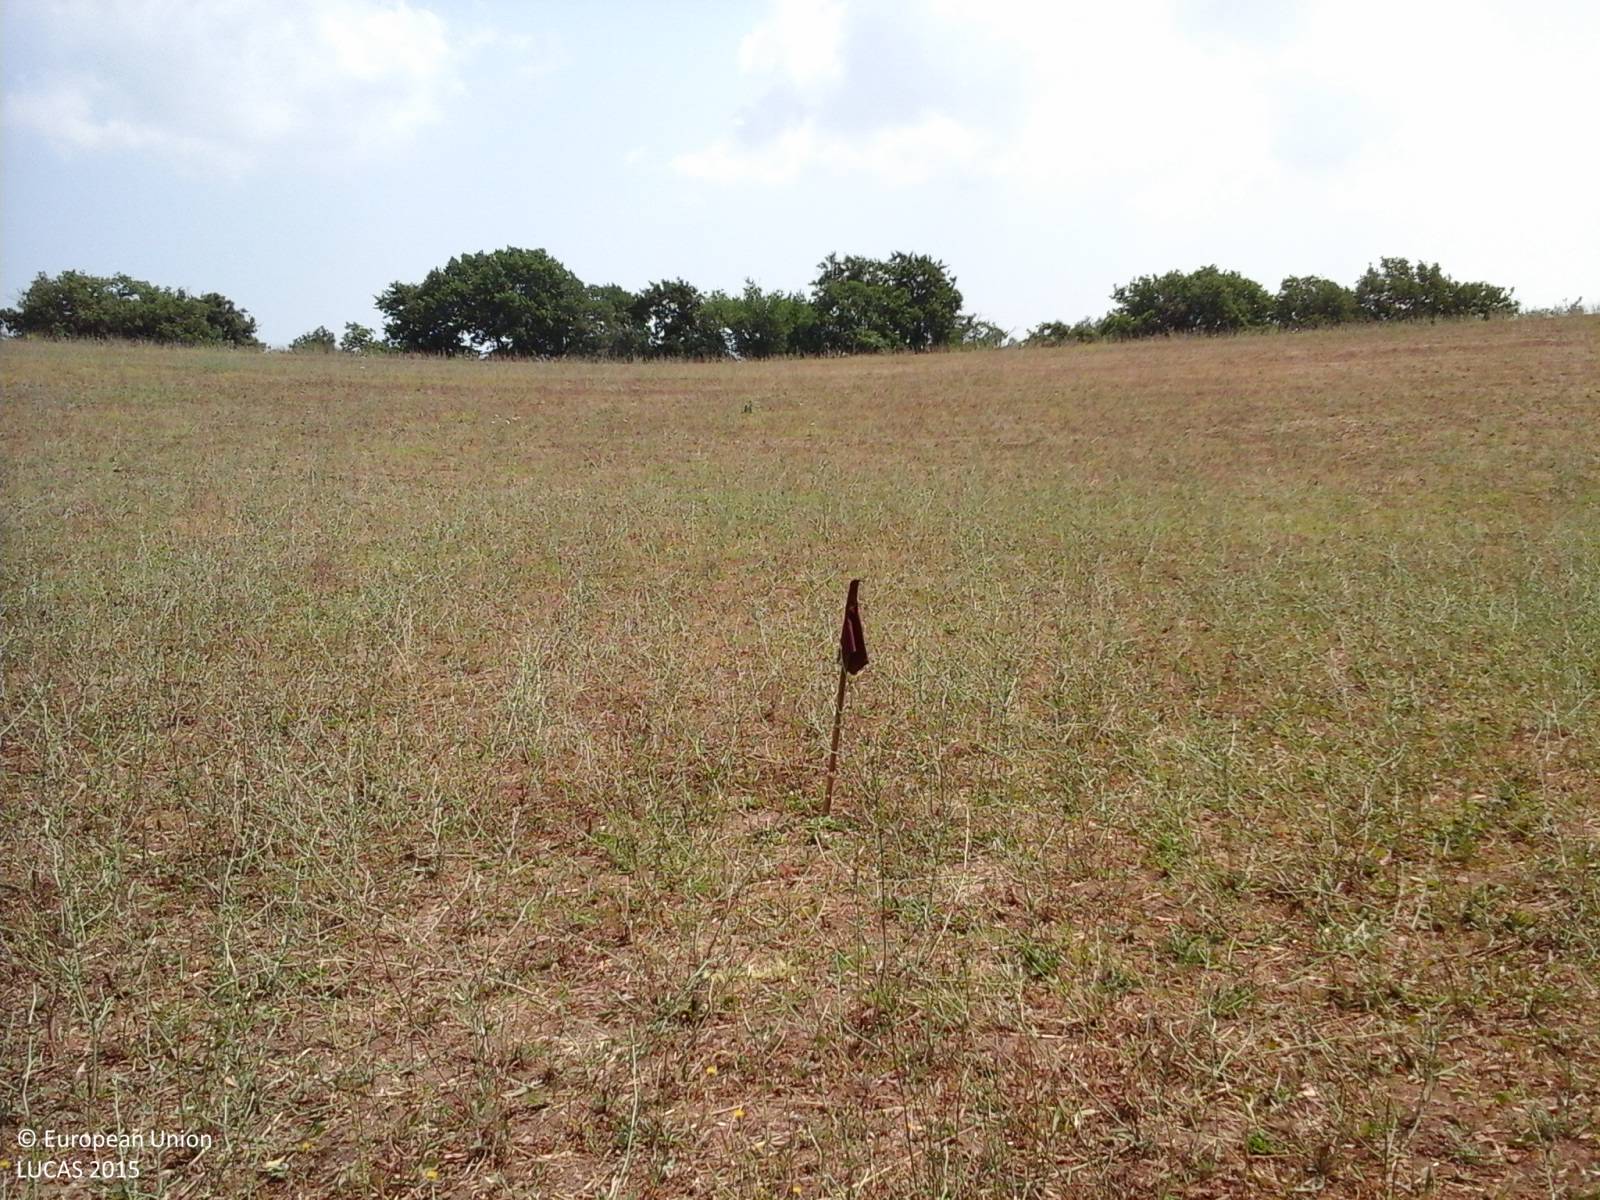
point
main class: Cropland
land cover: Mixed cereals for fodder
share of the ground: > 75 %
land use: Agriculture (excluding fallow land and kitchen gardens)
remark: Harvested field
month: July
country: IT
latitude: 41.9790
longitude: 12.2245
